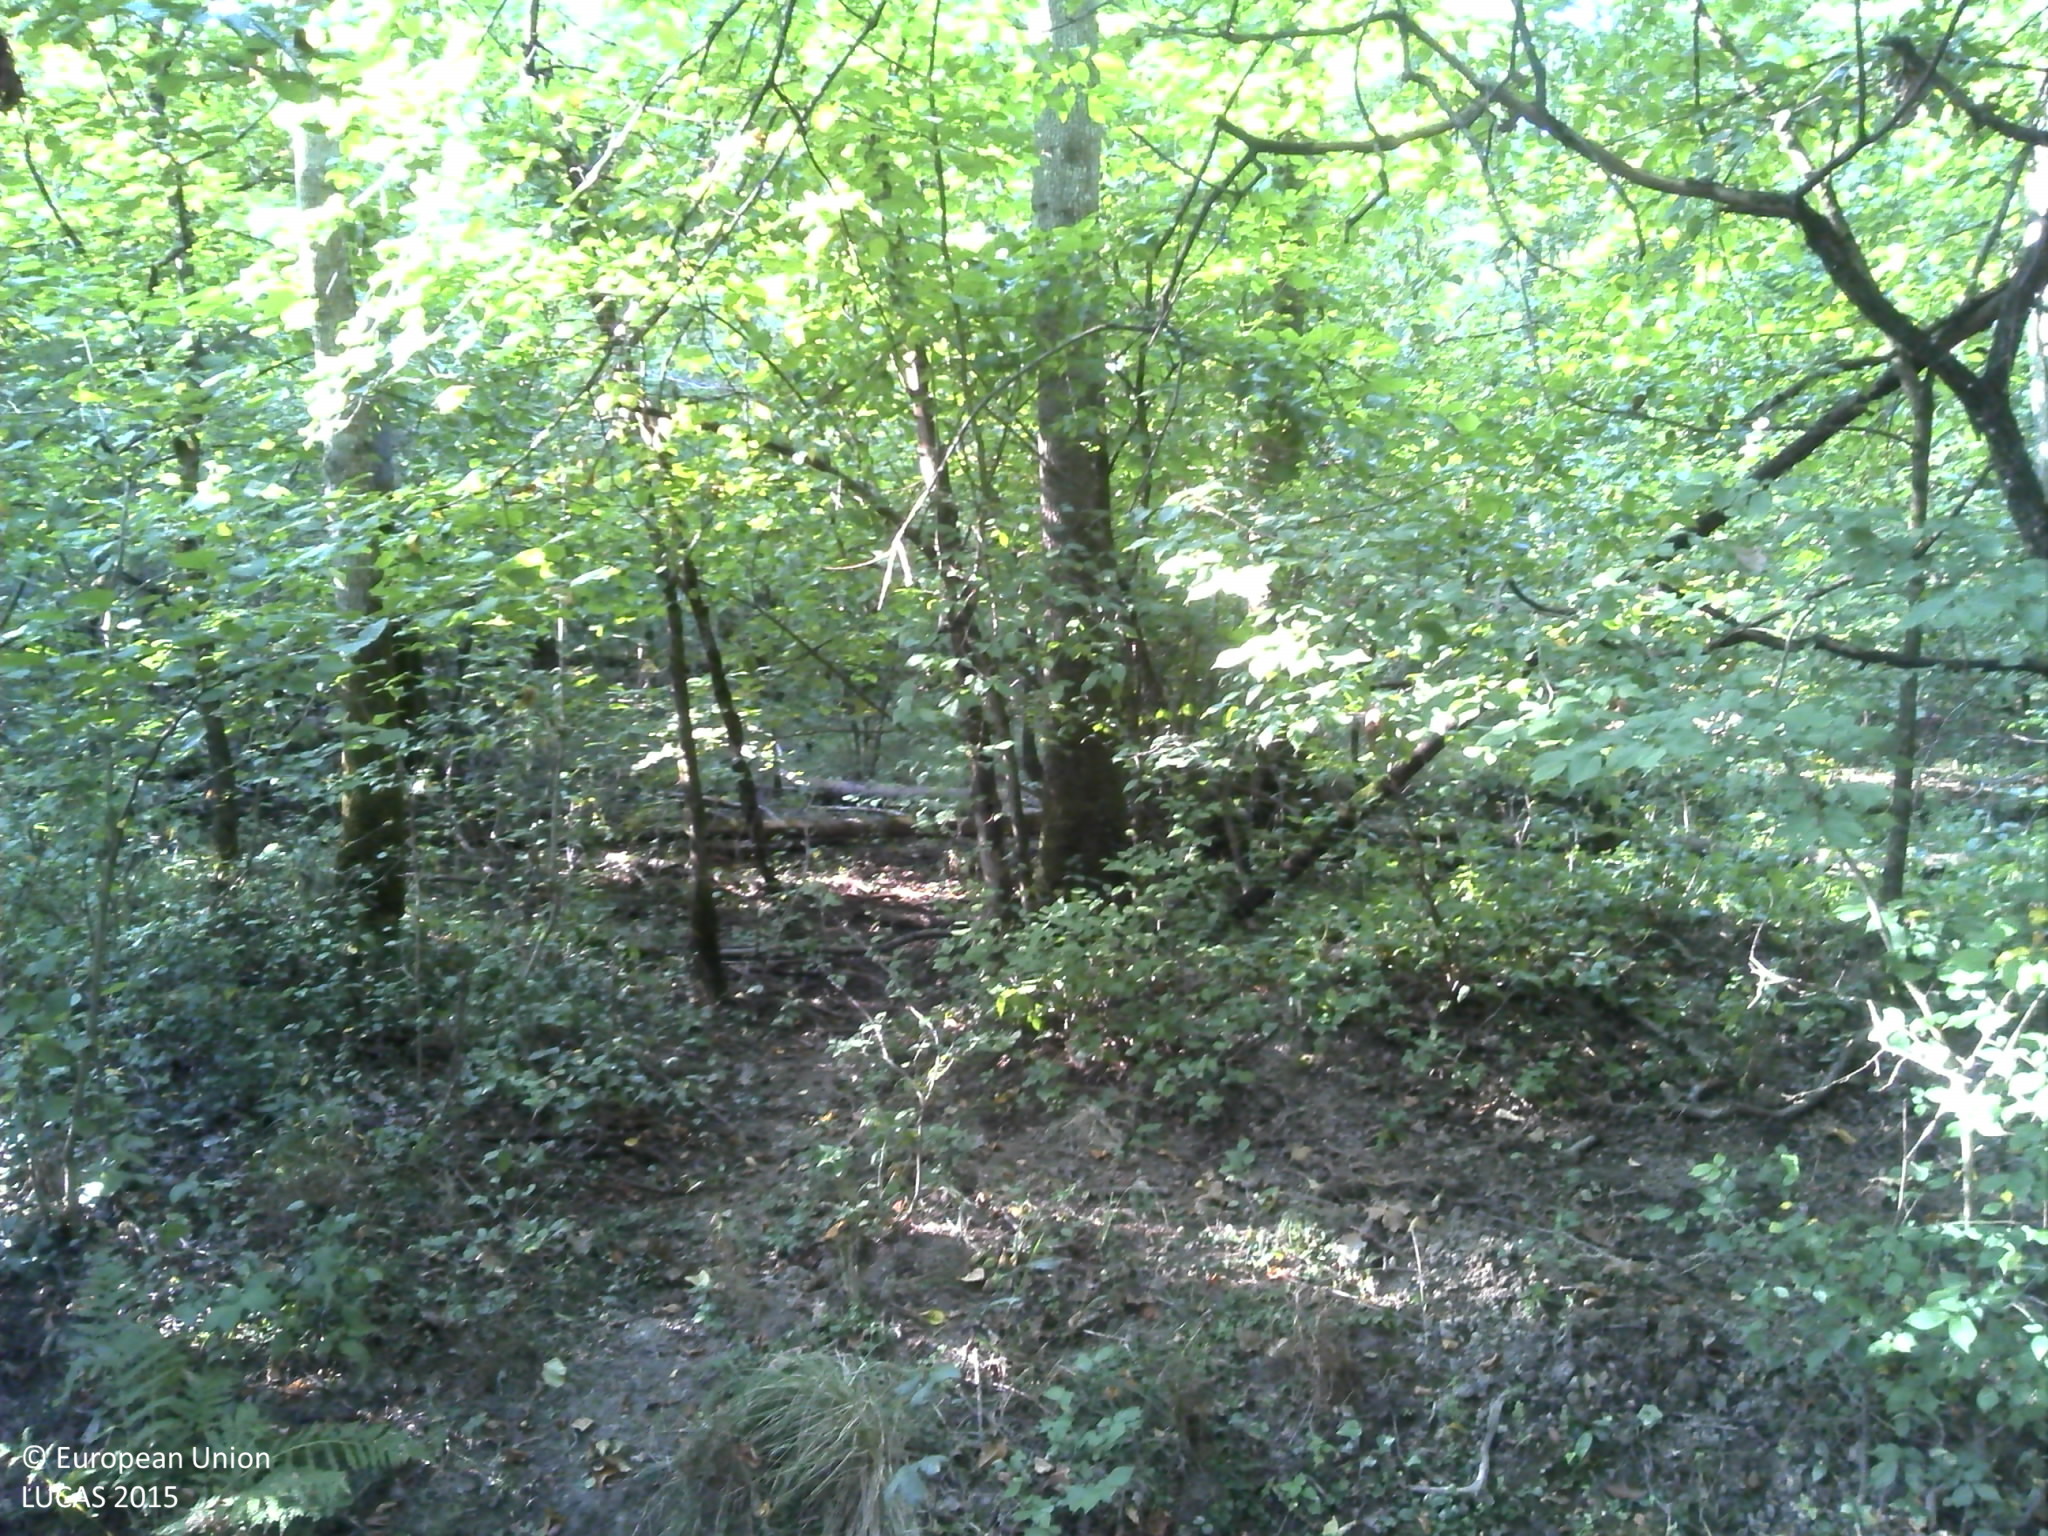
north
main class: Woodland
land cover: Broadleaved woodland
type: mesophytic deciduous forest
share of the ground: > 75 %
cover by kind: broadleaved forest trees 100 %
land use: Forestry
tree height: > 5 m
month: September
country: HR
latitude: 45.5175
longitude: 15.6163
